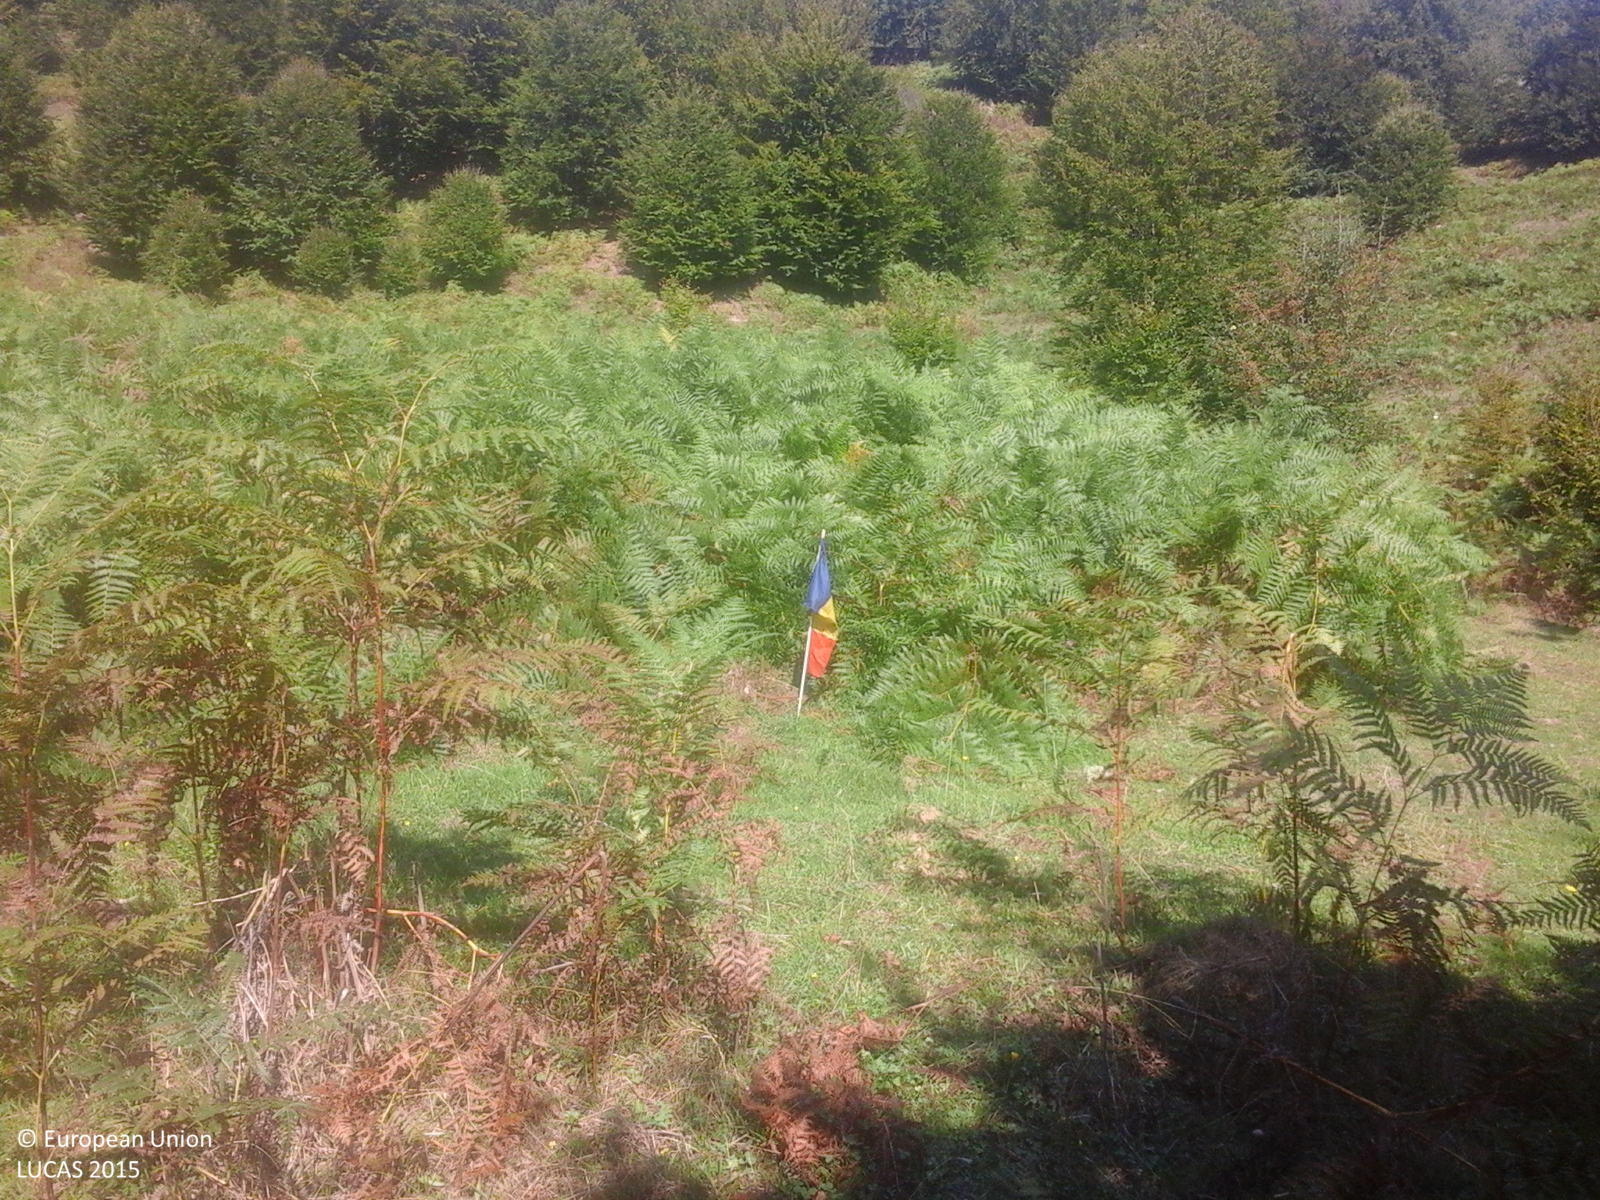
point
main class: Grassland
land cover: Spontaneously vegetated surfaces
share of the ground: > 75 %
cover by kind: herbaceous plants 100 %
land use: Semi-natural and natural areas not in use
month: September
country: RO
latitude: 46.8238
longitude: 22.4396
